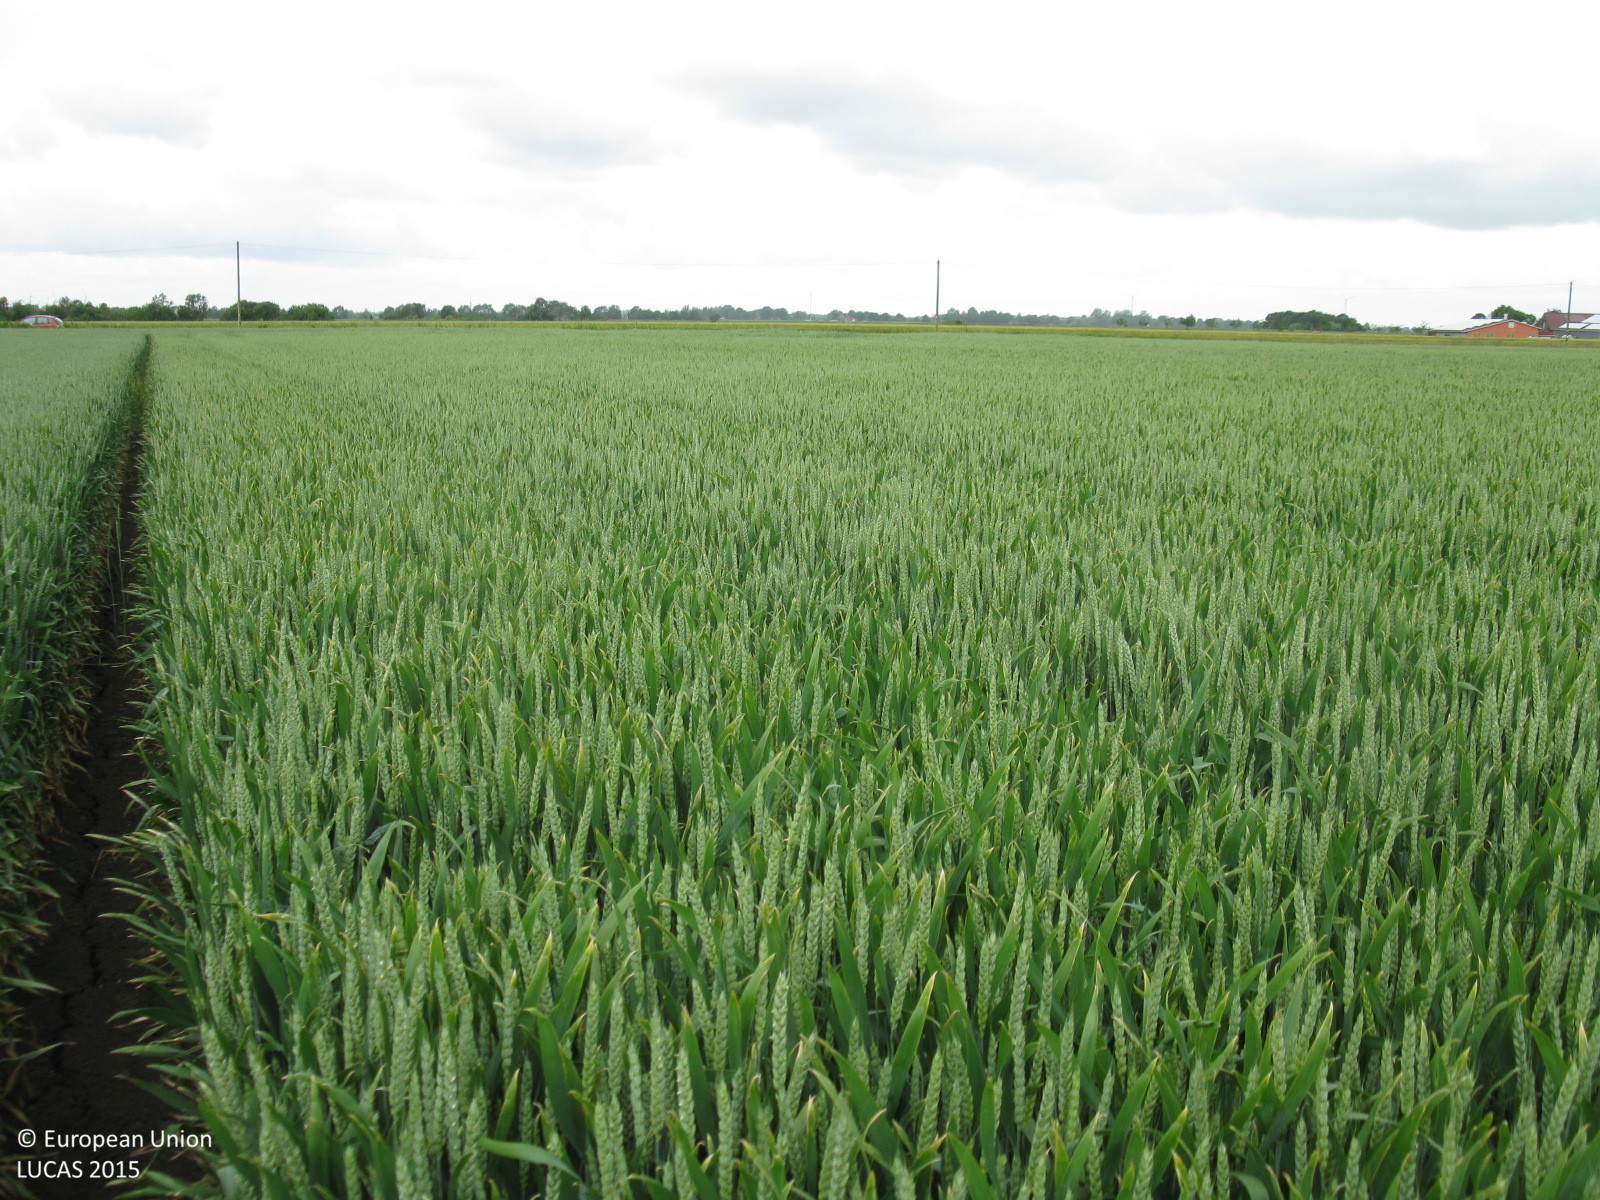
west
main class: Cropland
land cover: Common wheat
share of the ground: > 75 %
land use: Agriculture (excluding fallow land and kitchen gardens)
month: June
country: DE
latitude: 53.3721
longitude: 7.3102
